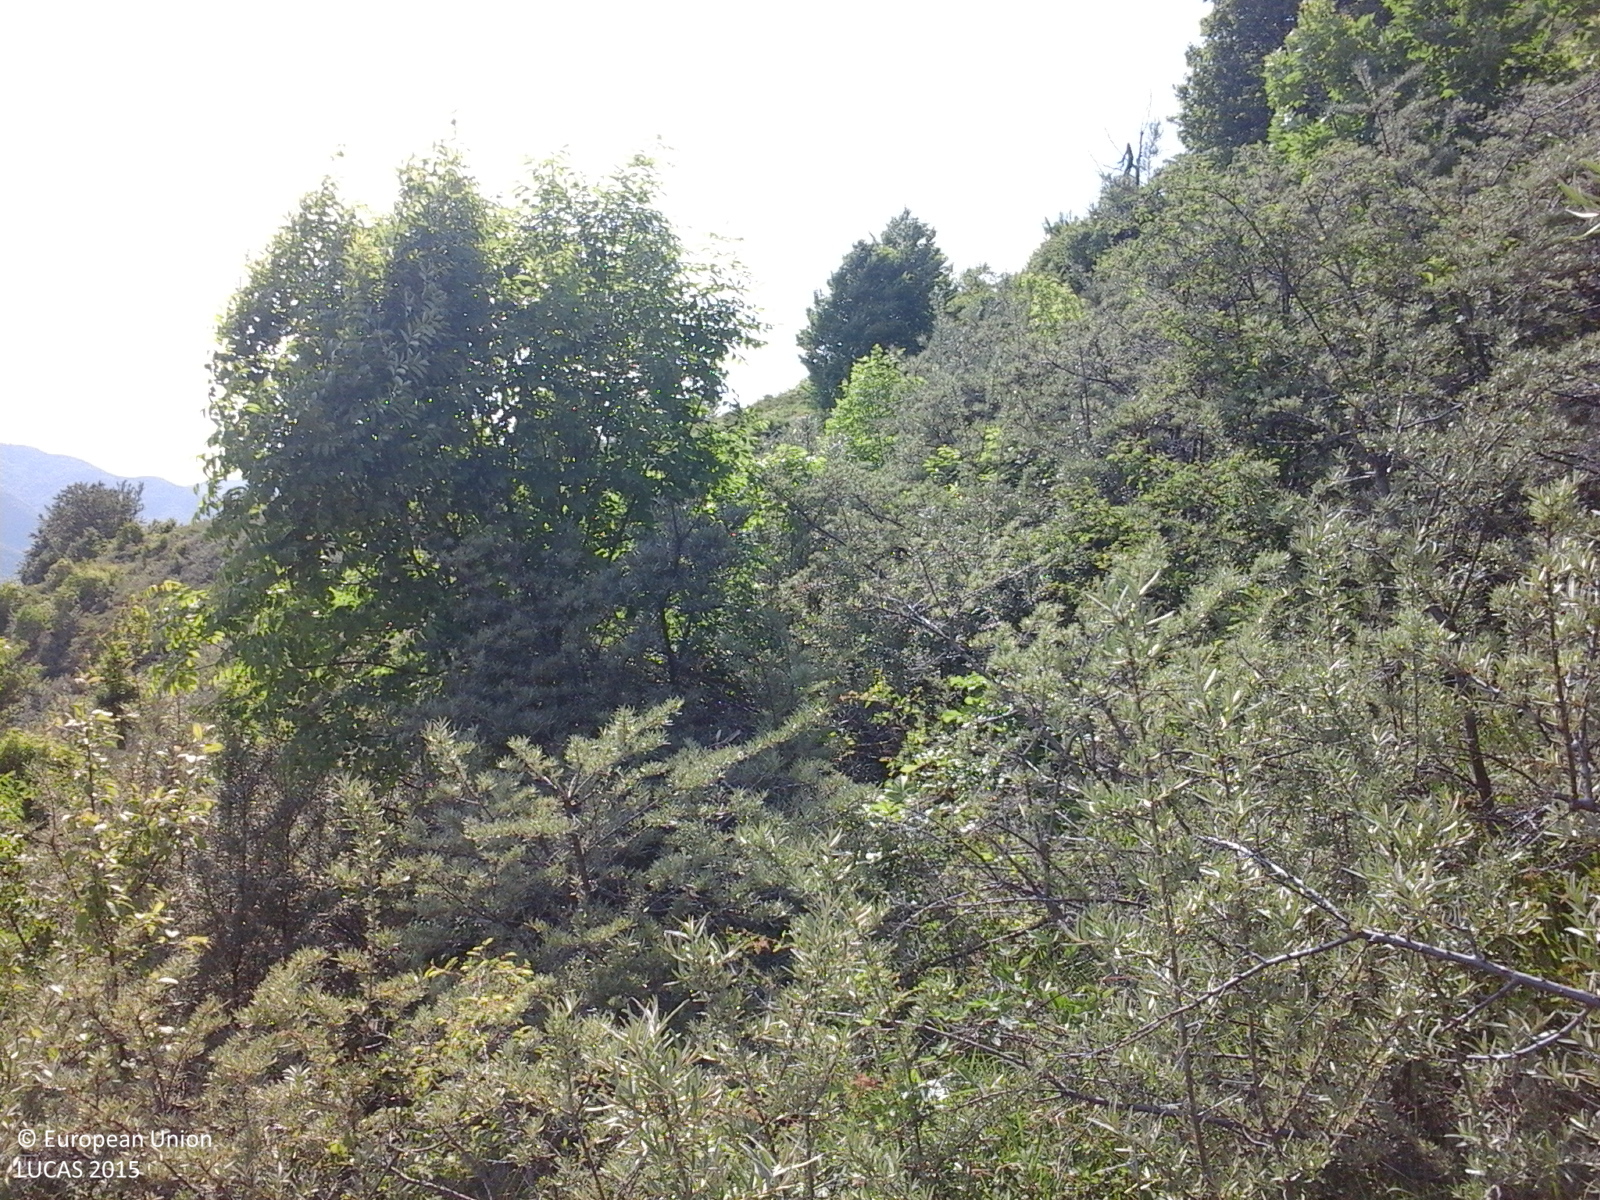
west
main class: Shrubland
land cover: Shrubland with sparse tree cover
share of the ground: > 75 %
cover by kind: shrubs 95 %, broadleaved forest trees 5 %
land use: Forestry
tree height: < 5 m
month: May
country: RO
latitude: 45.4228
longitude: 26.2862
